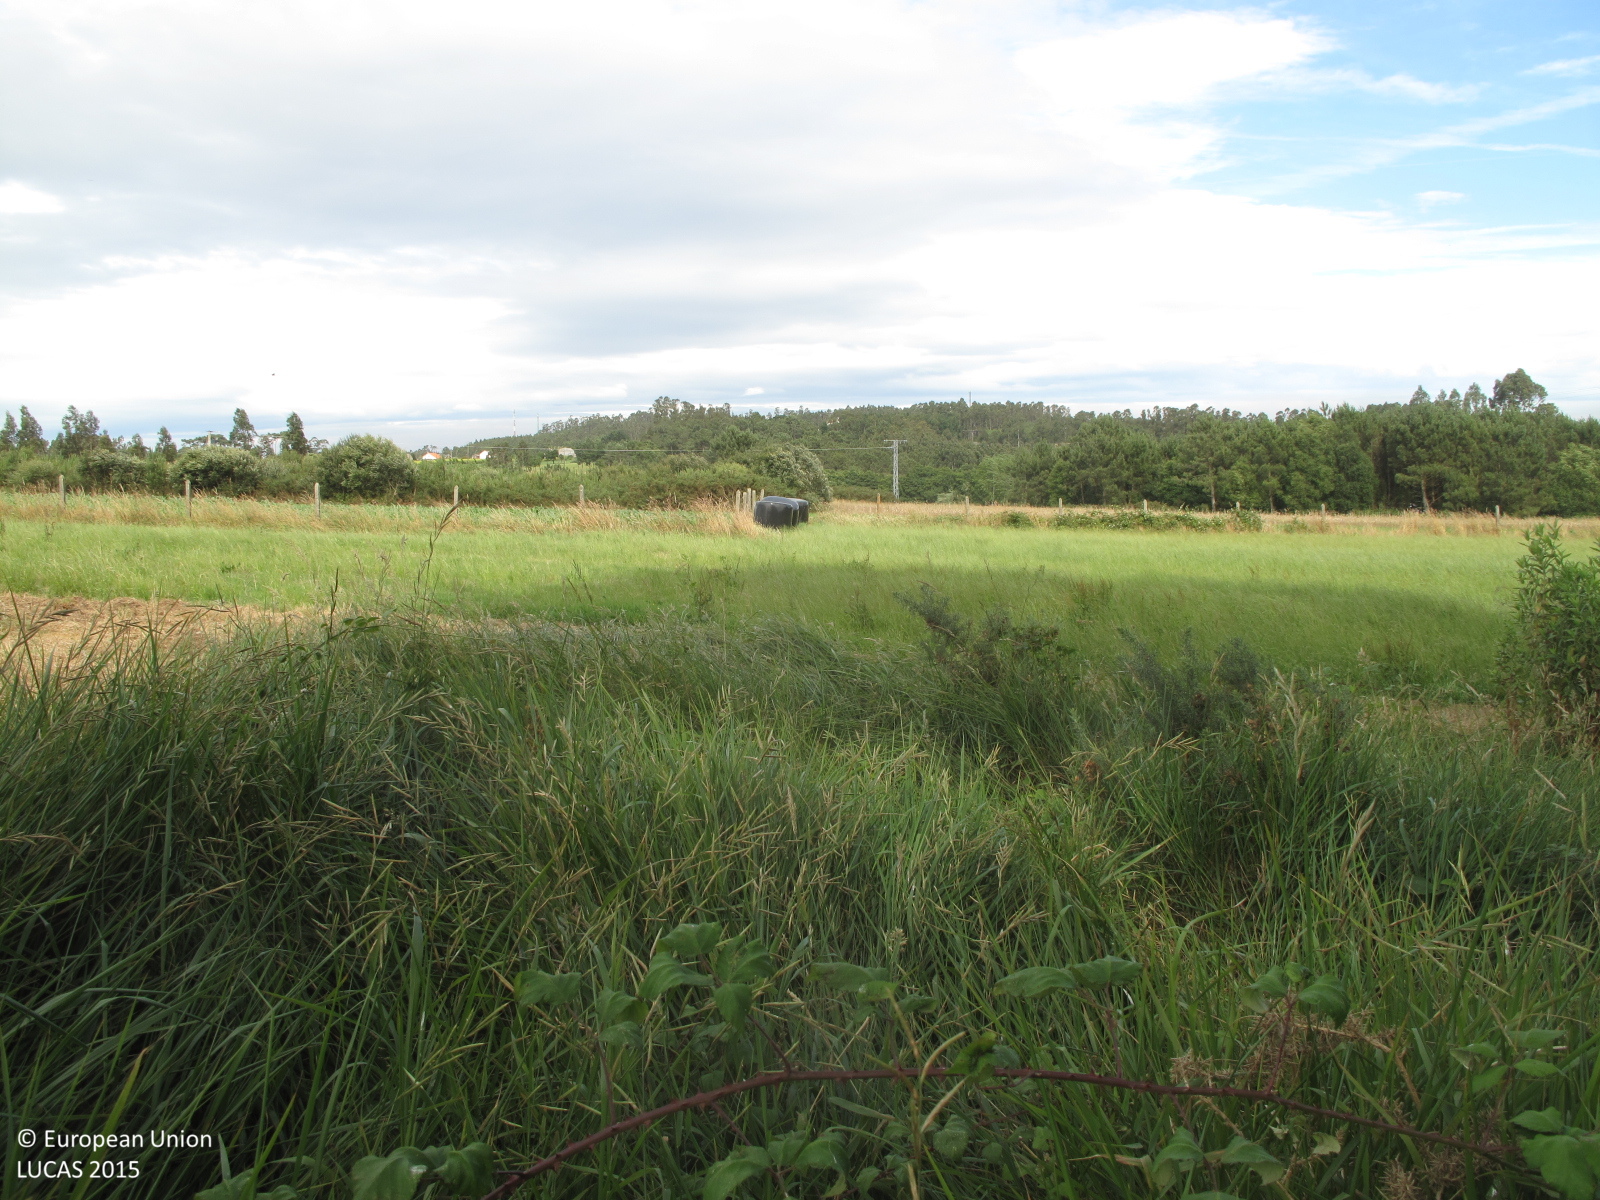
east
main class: Woodland
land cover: Pine dominated mixed woodland
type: exotic forest
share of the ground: 50 - 75 %
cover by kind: coniferous forest trees 40 %, broadleaved forest trees 20 %, shrubs 20 %, herbaceous plants 20 %
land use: Forestry
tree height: > 5 m
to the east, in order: Pine dominated mixed woodland; Grassland without tree/shrub cover; Maize; Broadleaved woodland; Shrubland with sparse tree cover; Paved roads, cycling and walking lanes; Grassland without tree/shrub cover
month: July
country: ES
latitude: 43.2642
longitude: -8.5781
